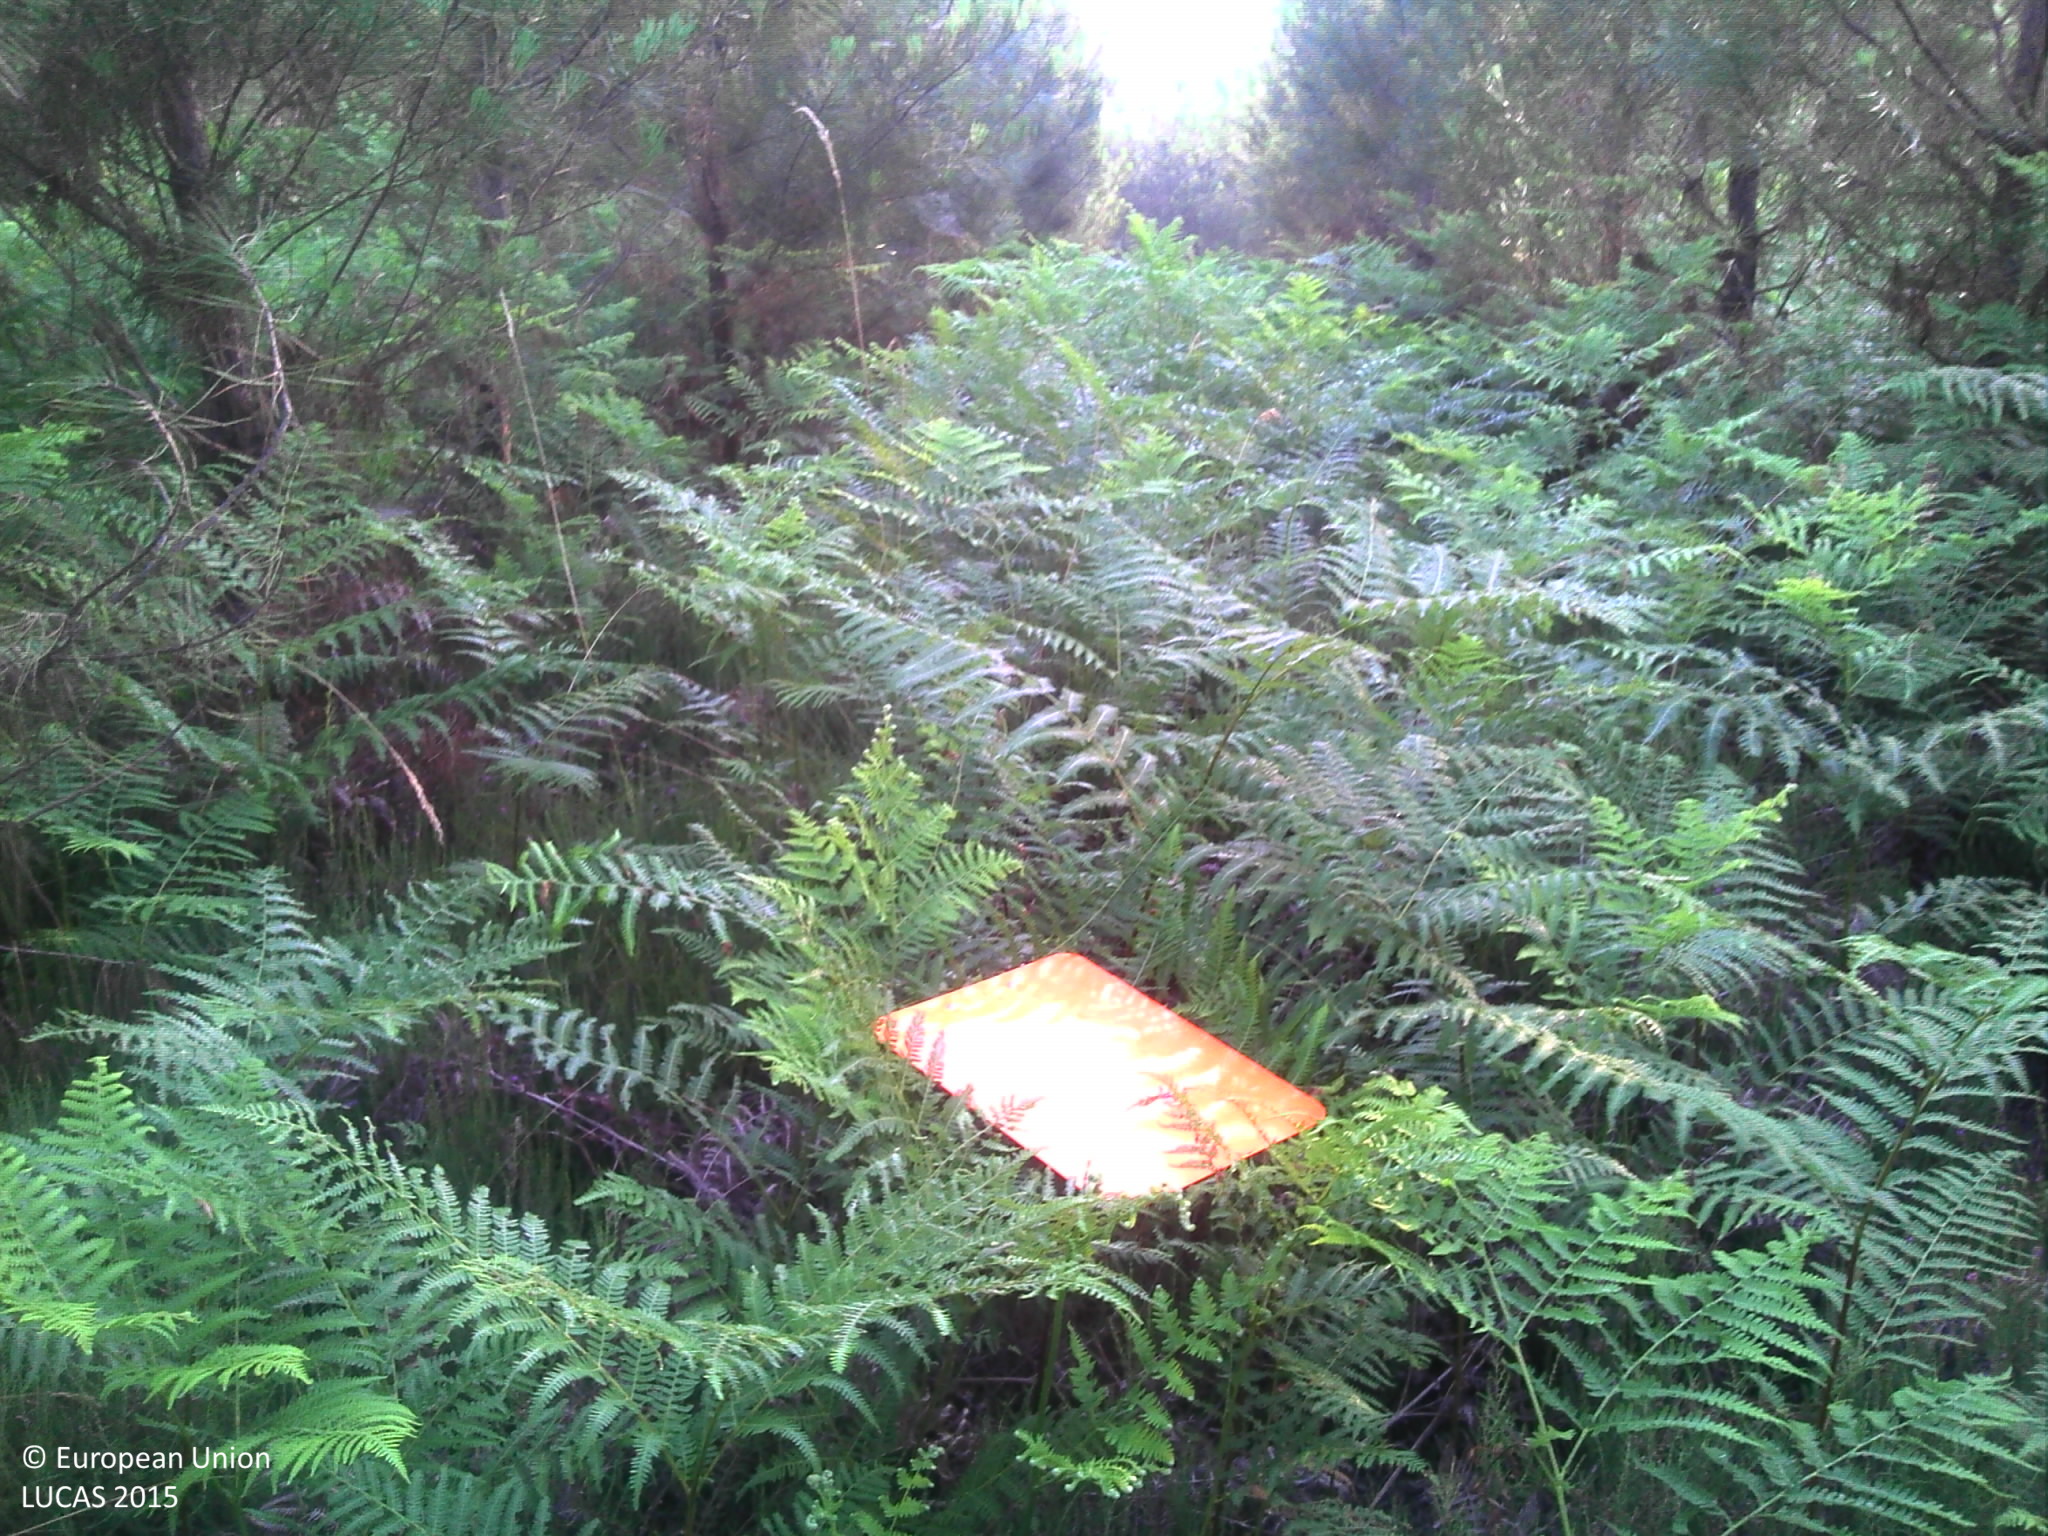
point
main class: Woodland
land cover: Pine dominated coniferous woodland
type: exotic forest
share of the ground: > 75 %
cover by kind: coniferous forest trees 70 %, herbaceous plants 30 %
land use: Forestry
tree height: > 5 m
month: July
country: FR
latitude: 44.1277
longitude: -0.2973
